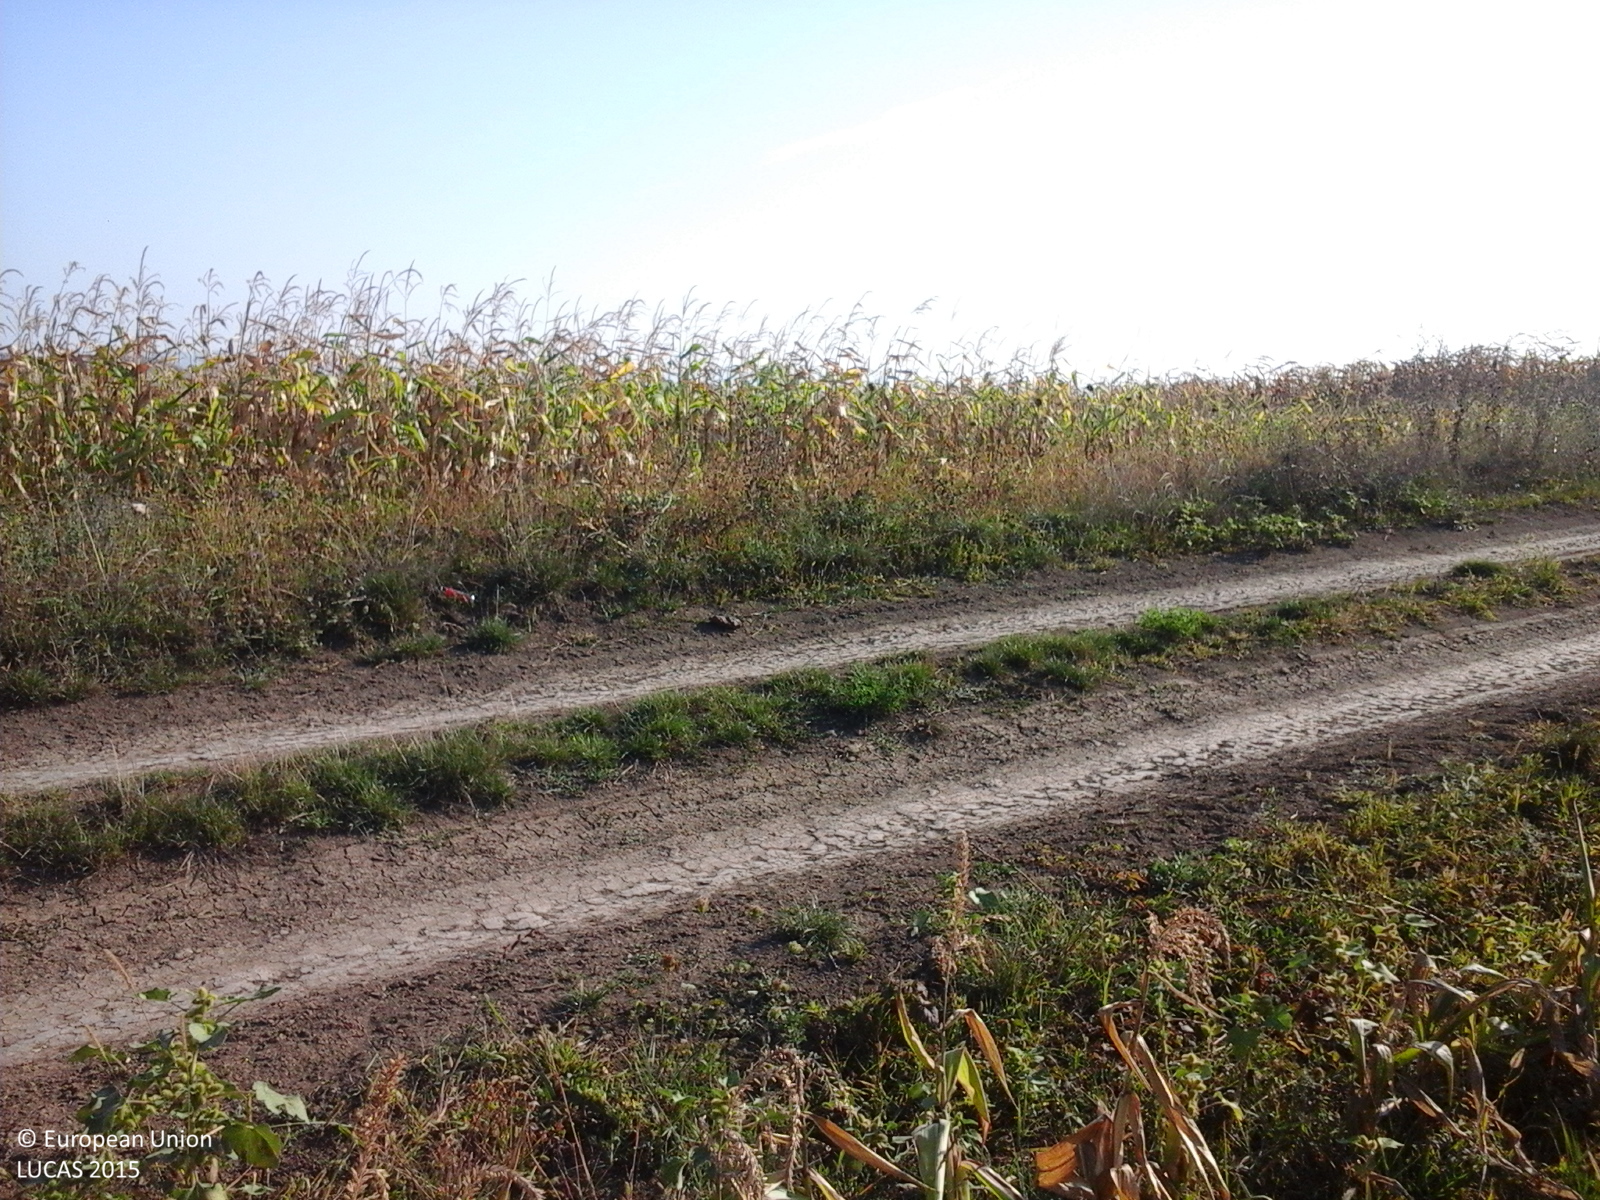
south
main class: Cropland
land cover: Maize
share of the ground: > 75 %
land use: Agriculture (excluding fallow land and kitchen gardens)
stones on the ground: < 10 %
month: September
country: RO
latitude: 47.3347
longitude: 23.0473
